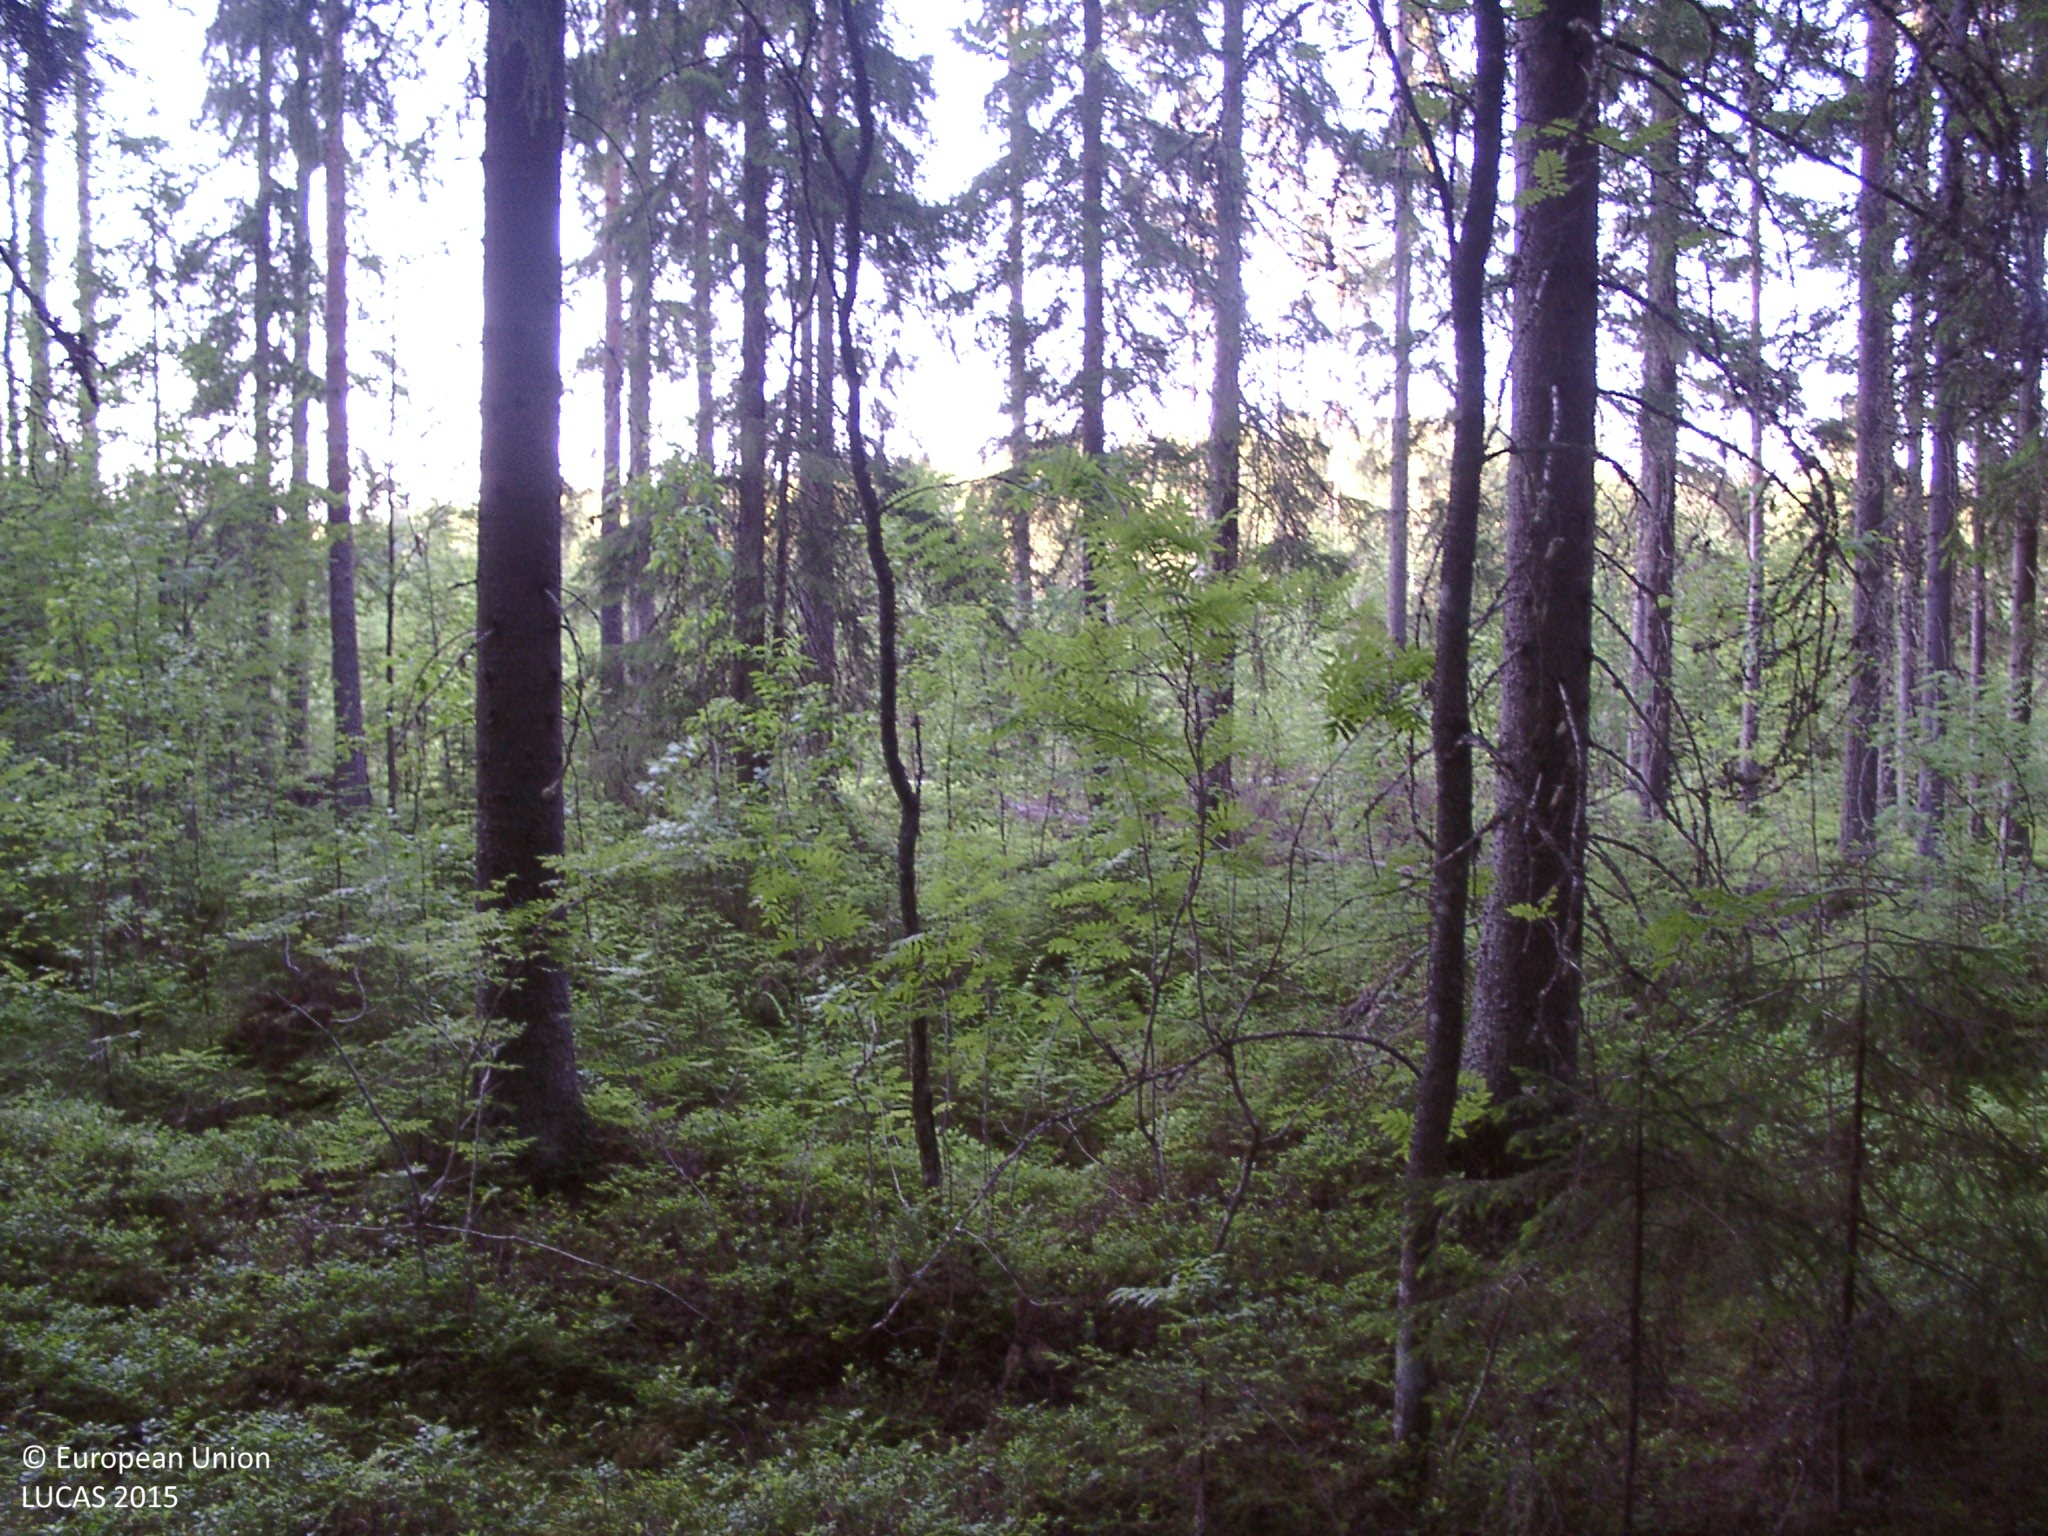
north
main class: Woodland
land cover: Spruce dominated coniferous woodland
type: boreal forest
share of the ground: > 75 %
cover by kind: coniferous forest trees 60 %, broadleaved forest trees 15 %, shrubs 10 %, lichens and mosses 10 %, herbaceous plants 5 %
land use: Forestry
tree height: > 5 m
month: July
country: FI
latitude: 62.0938
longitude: 25.5344
